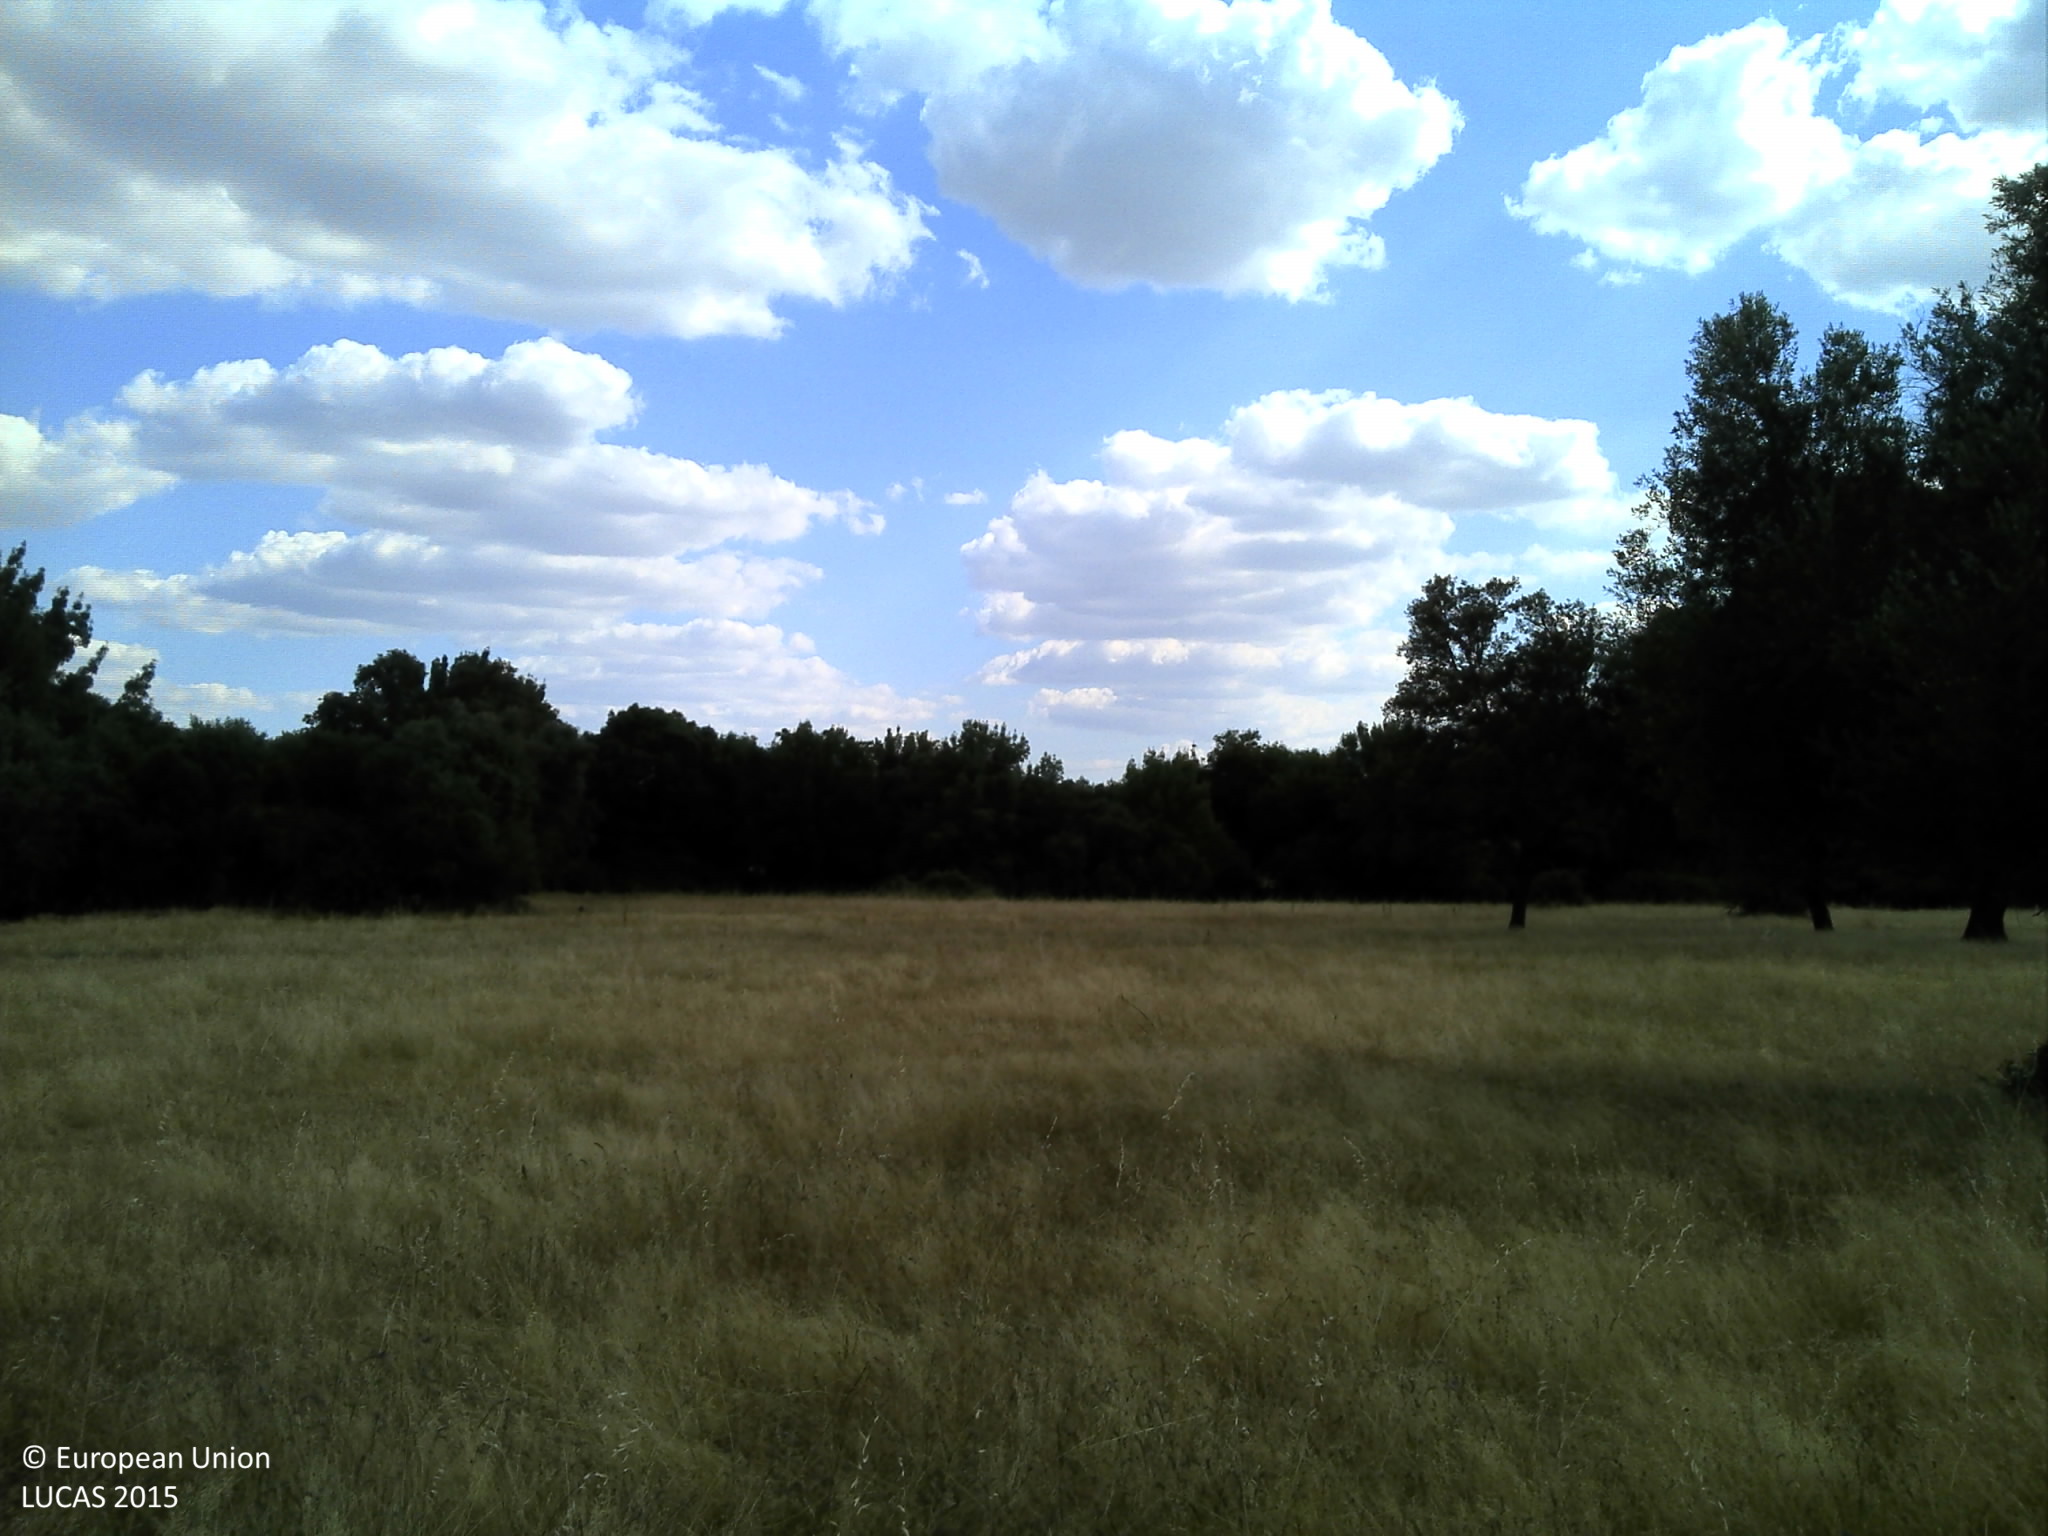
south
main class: Woodland
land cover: Broadleaved woodland
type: broadleaved evergreen forest
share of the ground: 10 - 25 %
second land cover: Grassland without tree/shrub cover
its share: 50 - 75 %
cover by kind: herbaceous plants 50 %, unconsolidated bare surface 35 %, broadleaved forest trees 15 %
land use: Forestry
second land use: Agriculture (excluding fallow land and kitchen gardens)
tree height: > 5 m
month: June
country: PT
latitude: 38.5117
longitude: -8.1998
